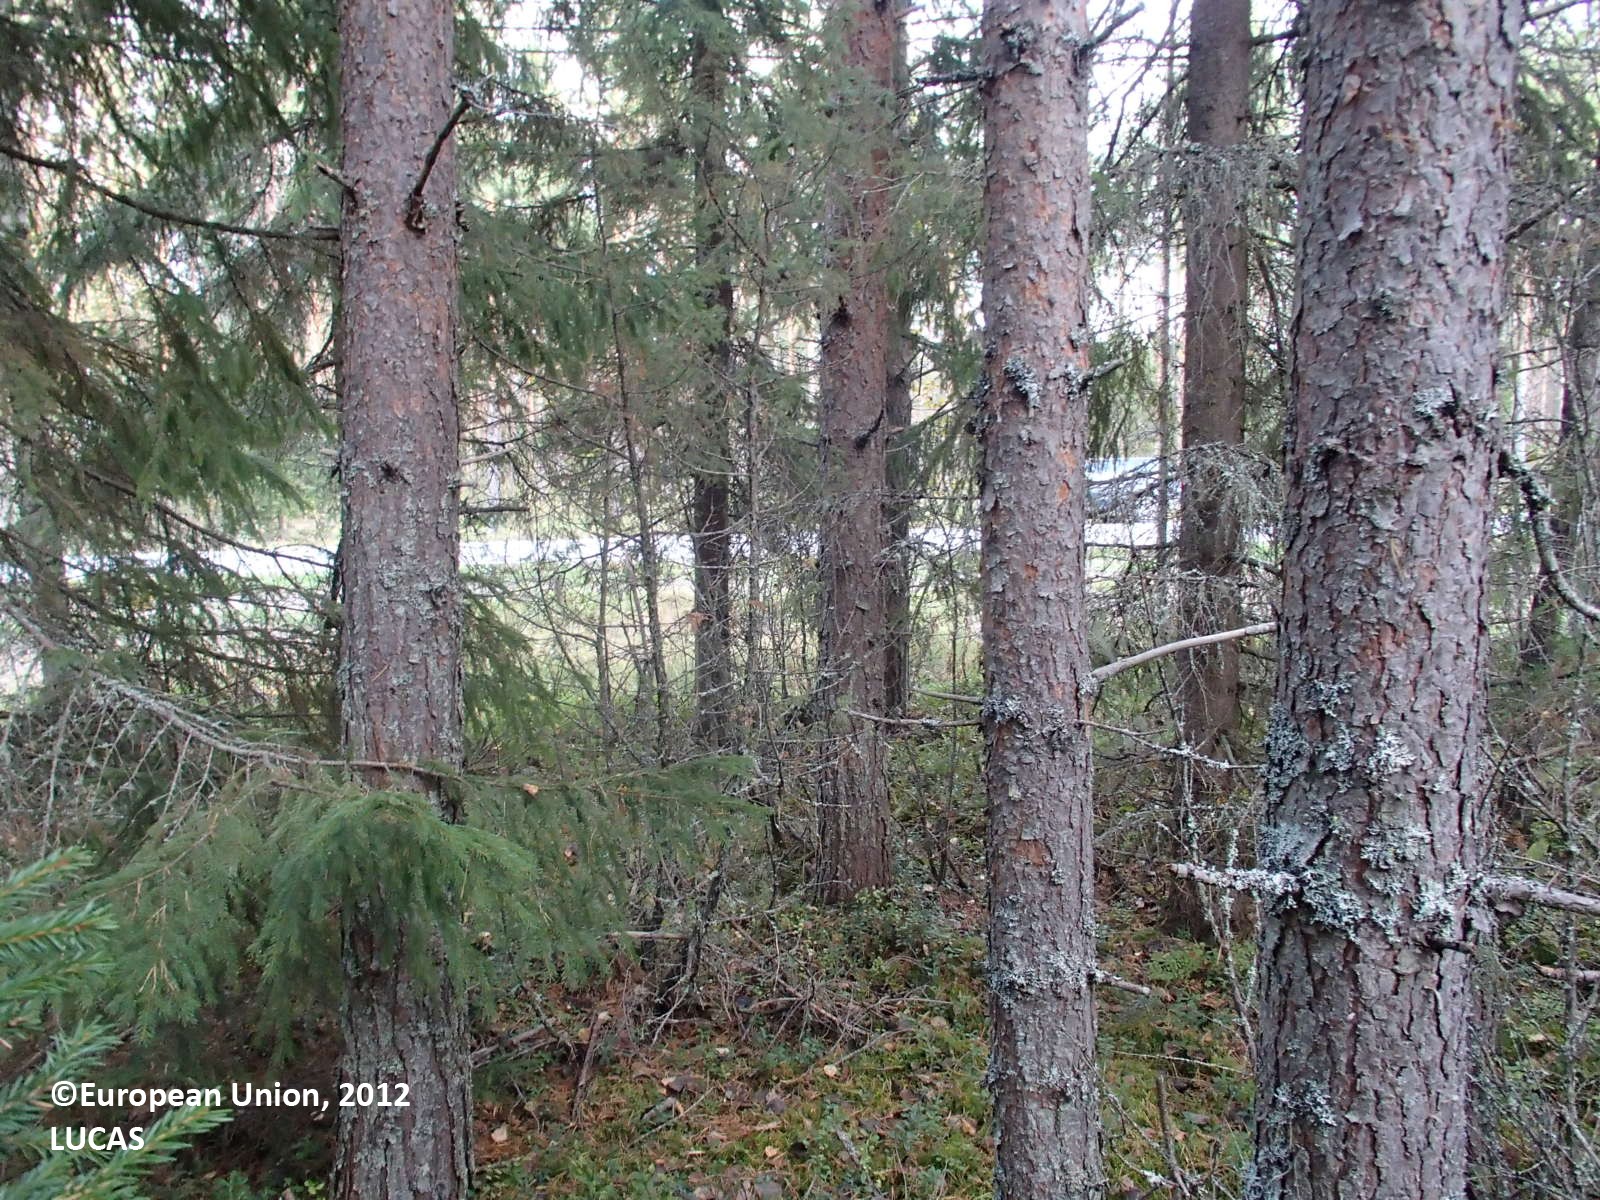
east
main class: Woodland
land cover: Other coniferous woodland
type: boreal forest
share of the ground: > 75 %
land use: Forestry
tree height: > 5 m
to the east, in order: Other coniferous woodland; Grass margins; Ditches and canals; Spontaneously vegetated surfaces; Paved roads, cycling and walking lanes; Spontaneously vegetated surfaces; Ditches and canals; Grass margins; Pine dominated coniferous woodland; Spontaneously vegetated surfaces; Spruce dominated mixed woodland
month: September
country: FI
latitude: 63.5911
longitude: 26.0541
